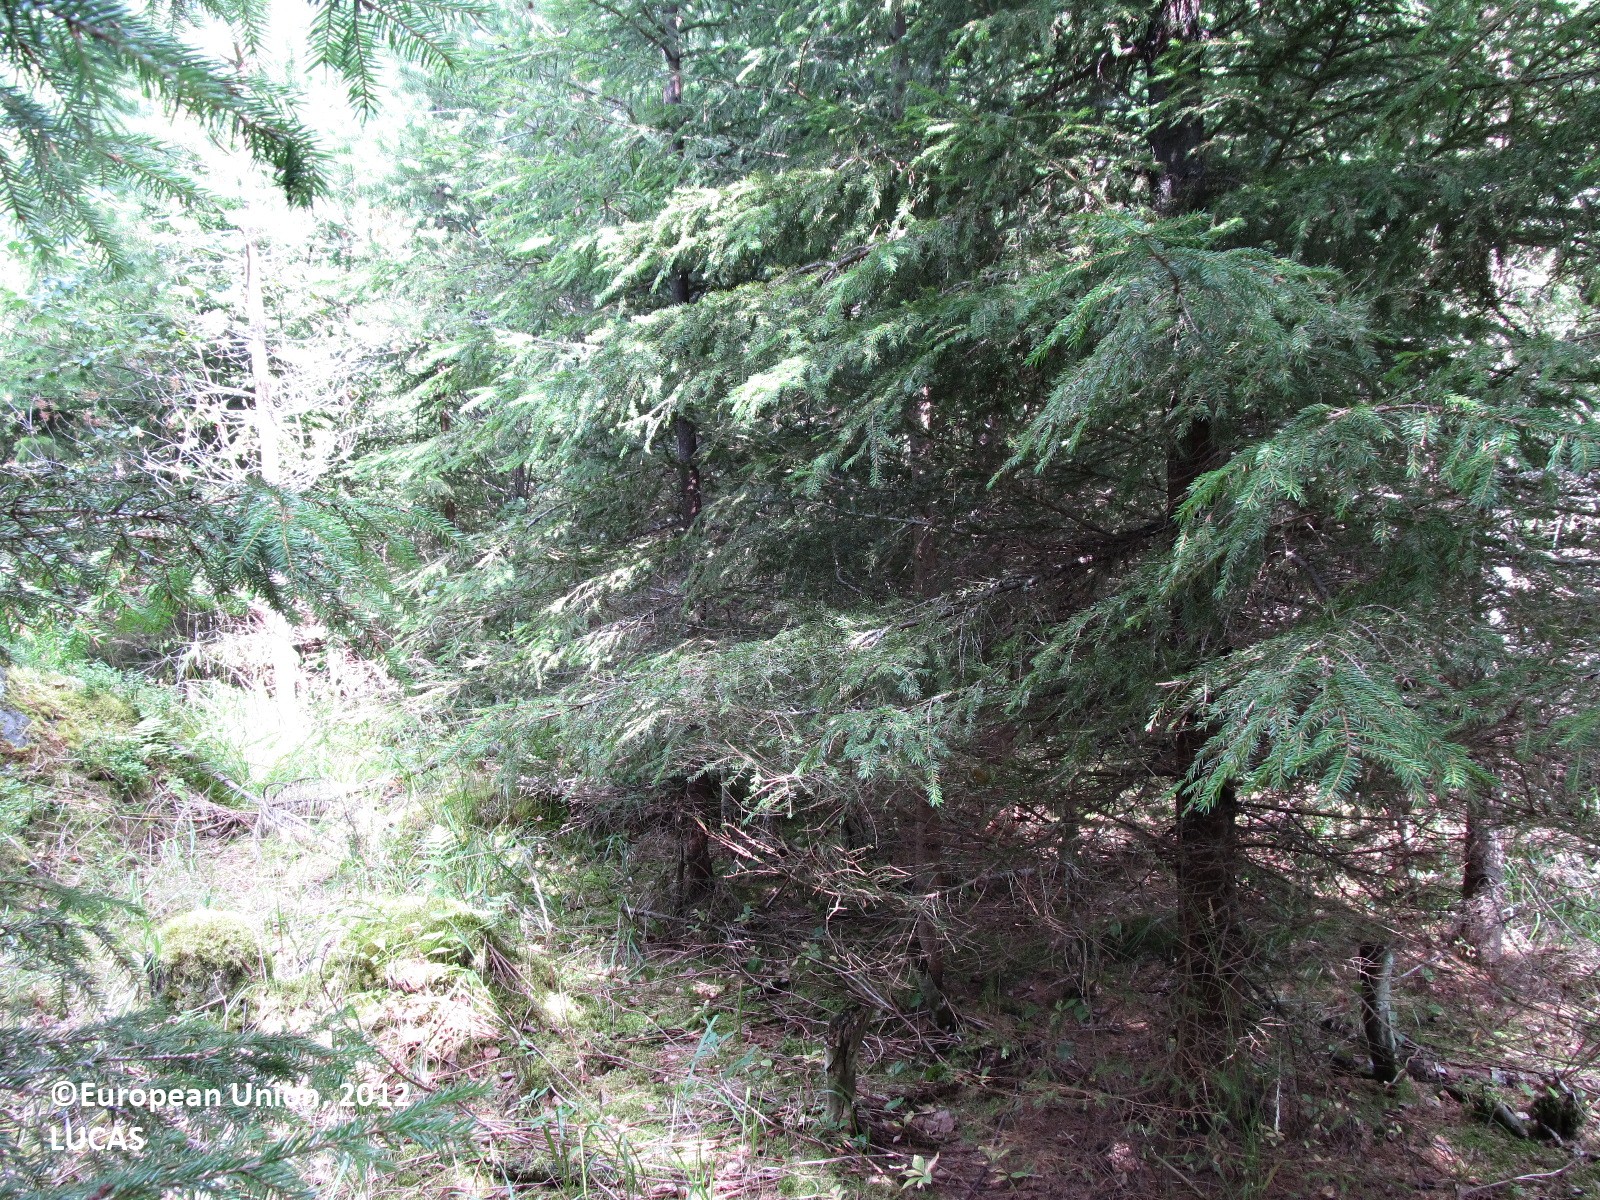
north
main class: Woodland
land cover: Spruce dominated coniferous woodland
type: boreal forest
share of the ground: 50 - 75 %
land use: Forestry
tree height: > 5 m
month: August
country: FI
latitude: 62.2183
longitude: 28.4534
